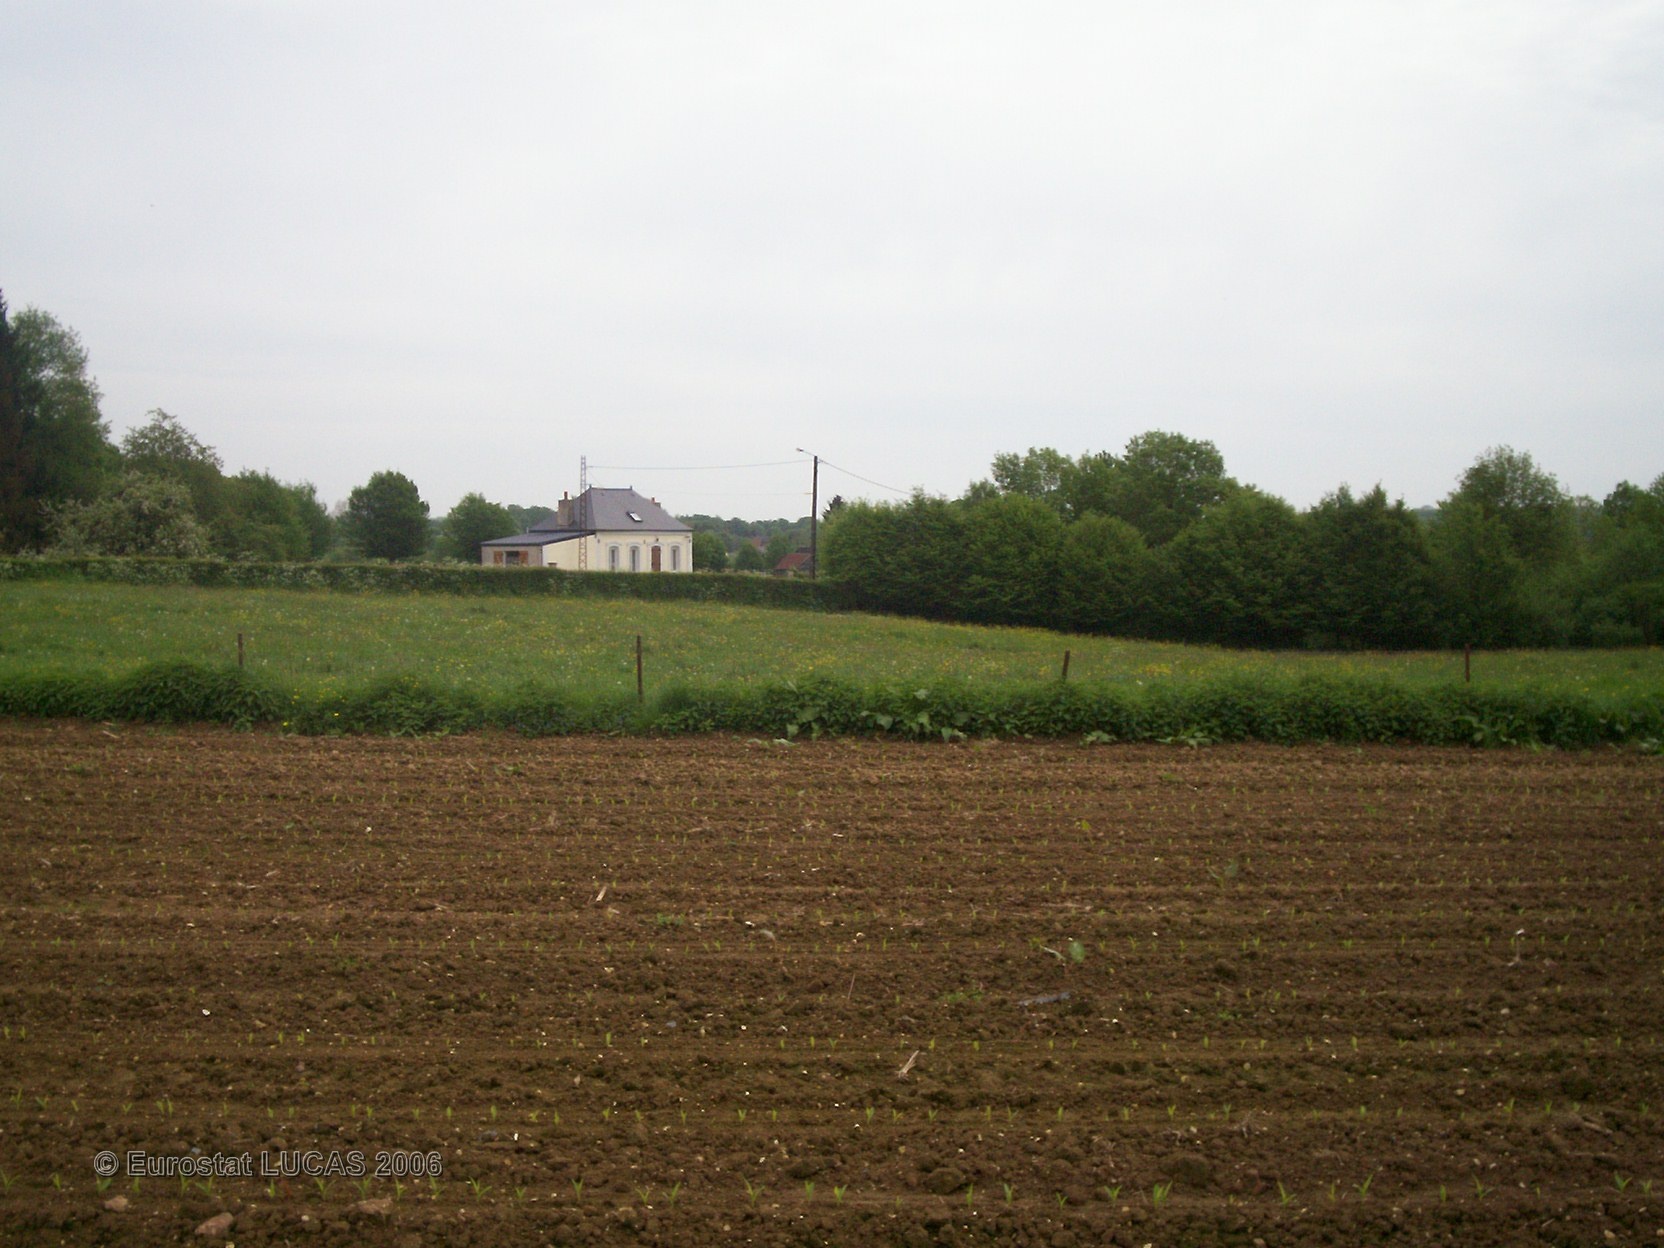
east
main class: Cropland
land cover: Maize
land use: Agriculture (excluding fallow land and kitchen gardens)
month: May
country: FR
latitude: 49.9594
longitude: 3.7627
